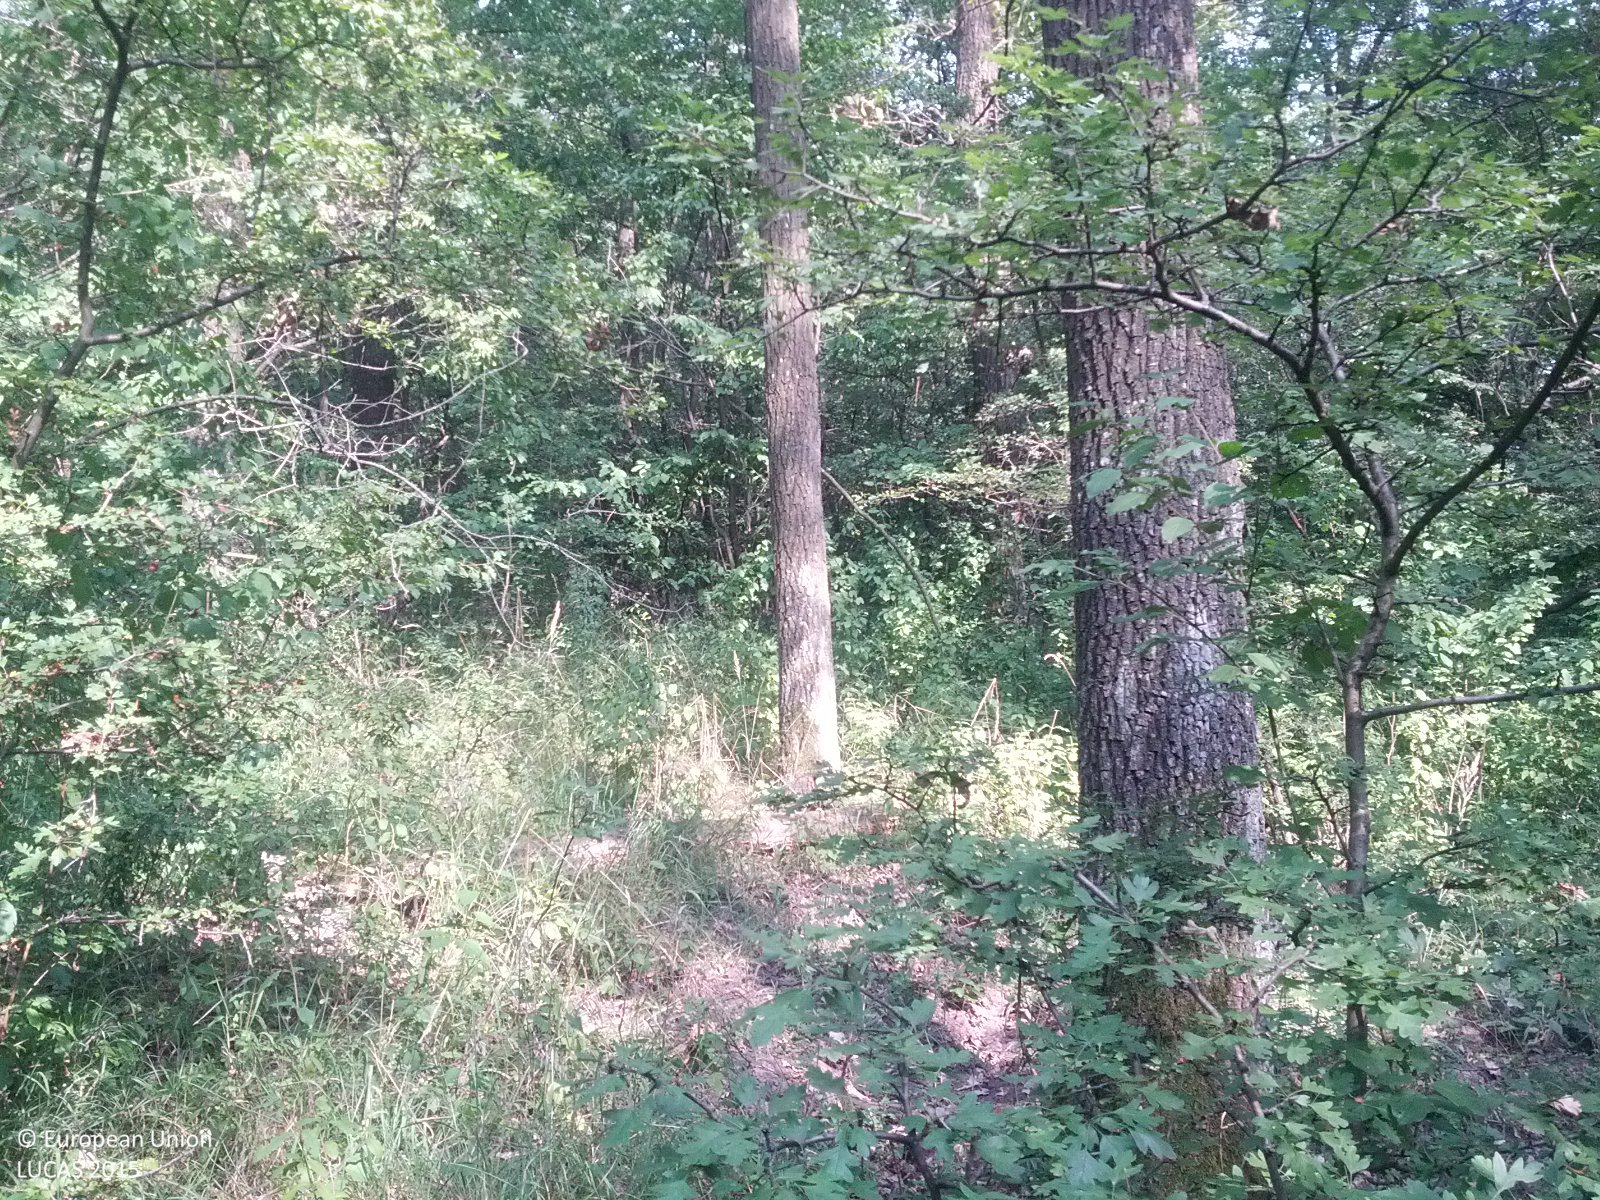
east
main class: Woodland
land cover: Broadleaved woodland
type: acidophilous oak and oak-birch forest
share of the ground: > 75 %
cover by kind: broadleaved forest trees 80 %, herbaceous plants 15 %, shrubs 5 %
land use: Forestry
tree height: > 5 m
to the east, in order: Broadleaved woodland; Fences; Grassland without tree/shrub cover
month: July
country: AT
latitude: 48.3856
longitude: 16.3112
